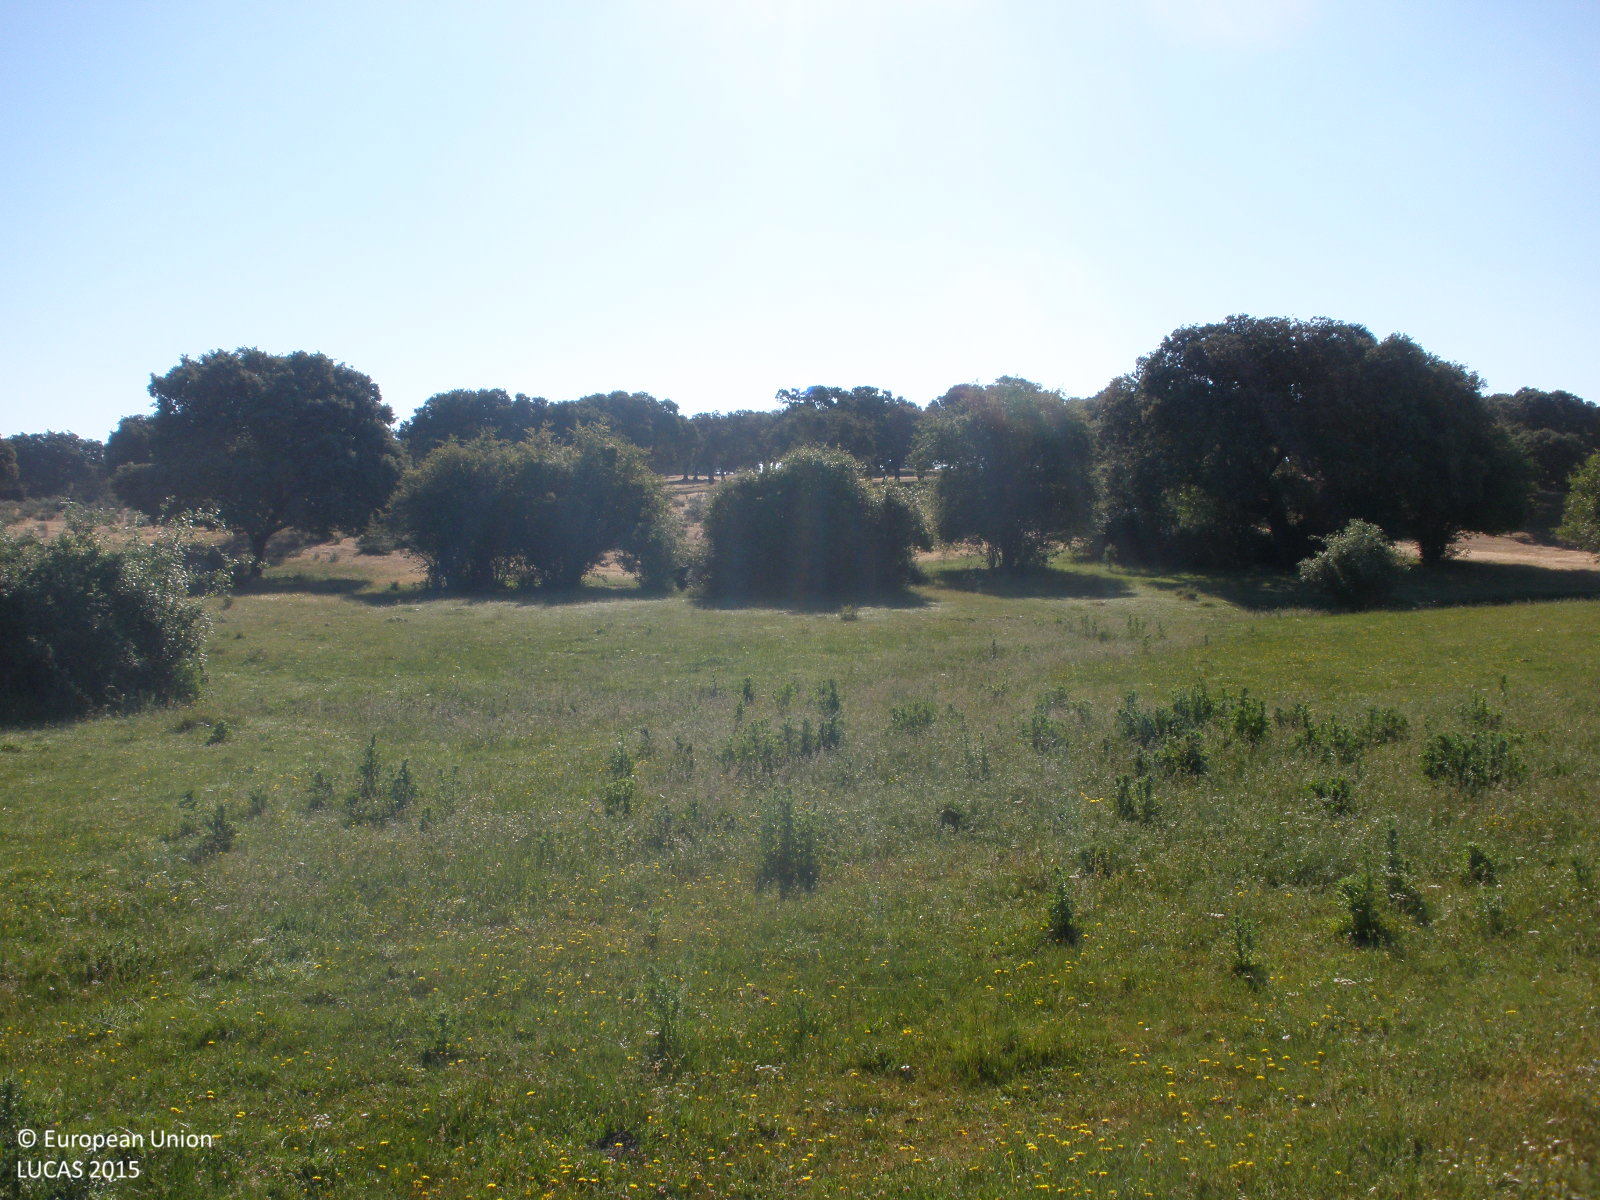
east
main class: Grassland
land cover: Grassland without tree/shrub cover
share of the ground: > 75 %
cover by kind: herbaceous plants 100 %
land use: Agriculture (excluding fallow land and kitchen gardens)
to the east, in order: Grassland without tree/shrub cover; Rivers and streams; Grassland without tree/shrub cover; Shrubland with sparse tree cover; Broadleaved woodland; Tracks; Broadleaved woodland
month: June
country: ES
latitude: 40.4572
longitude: -6.6344
